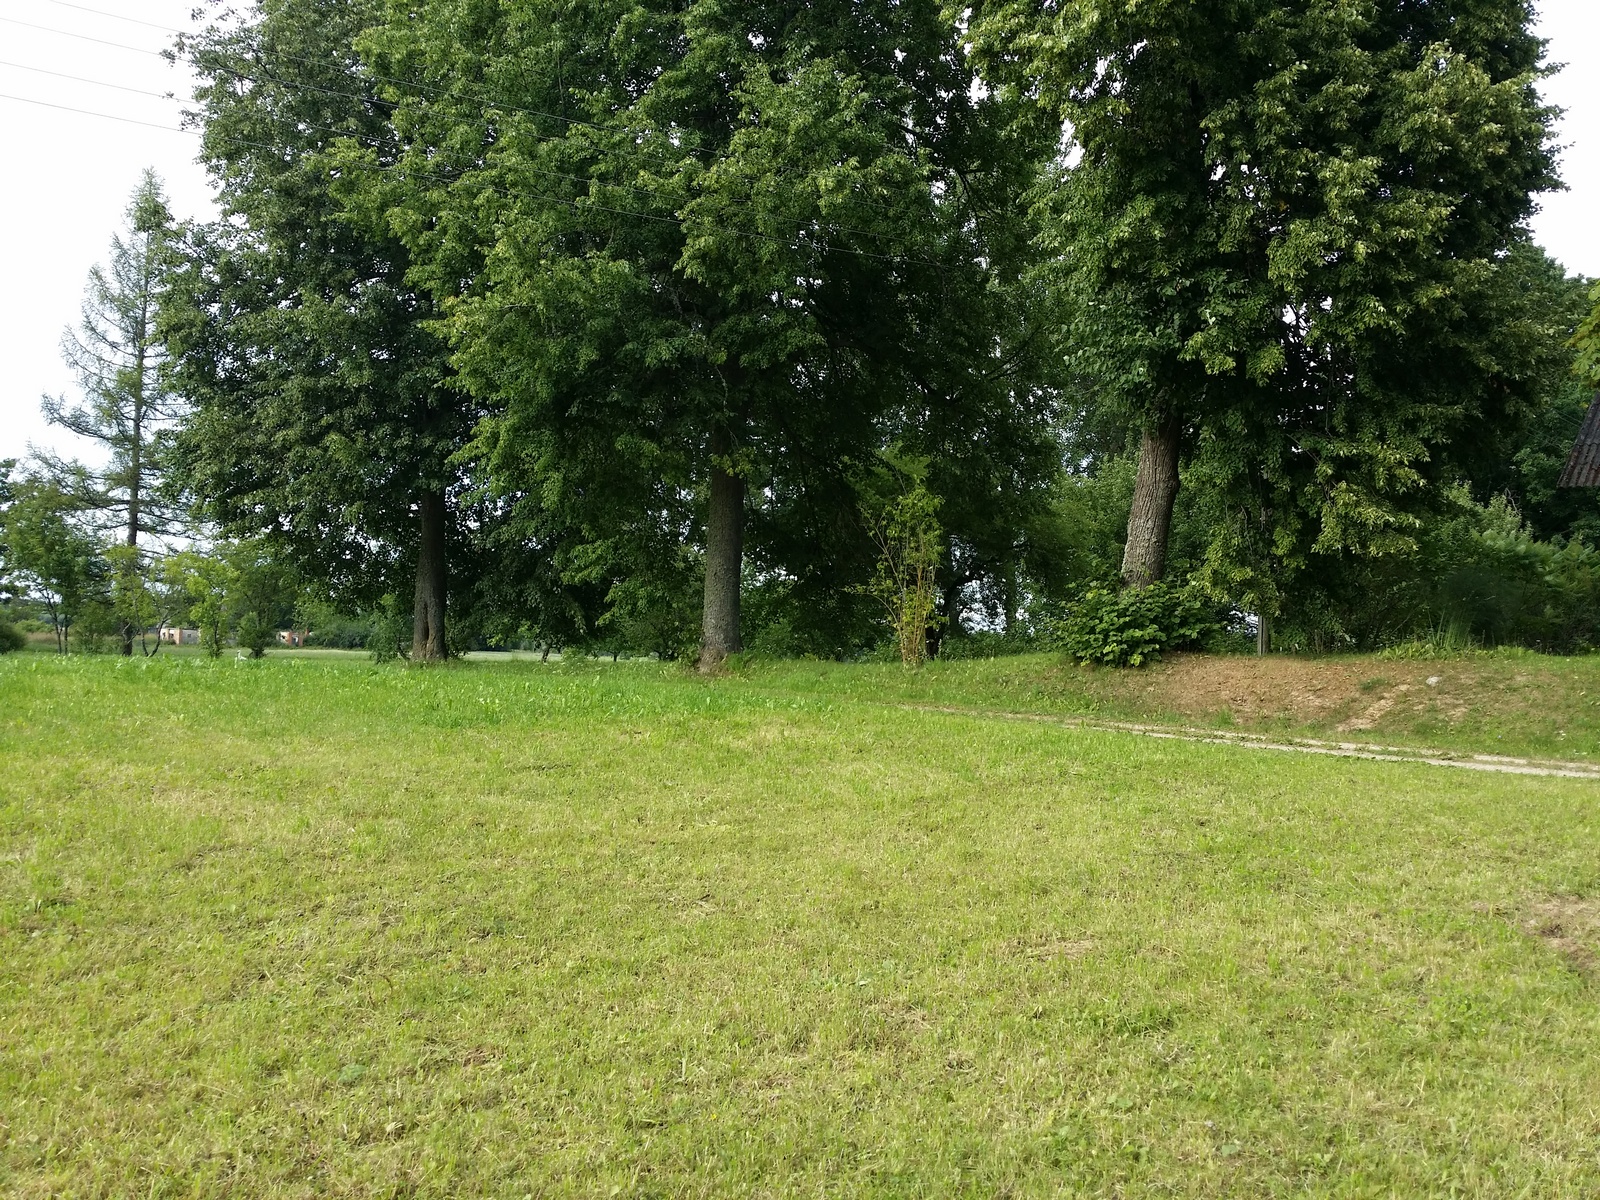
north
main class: Grassland
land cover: Grassland without tree/shrub cover
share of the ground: > 75 %
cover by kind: herbaceous plants 95 %, unconsolidated bare surface 5 %
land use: Residential
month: August
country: LV
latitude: 57.3798
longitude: 26.7329
